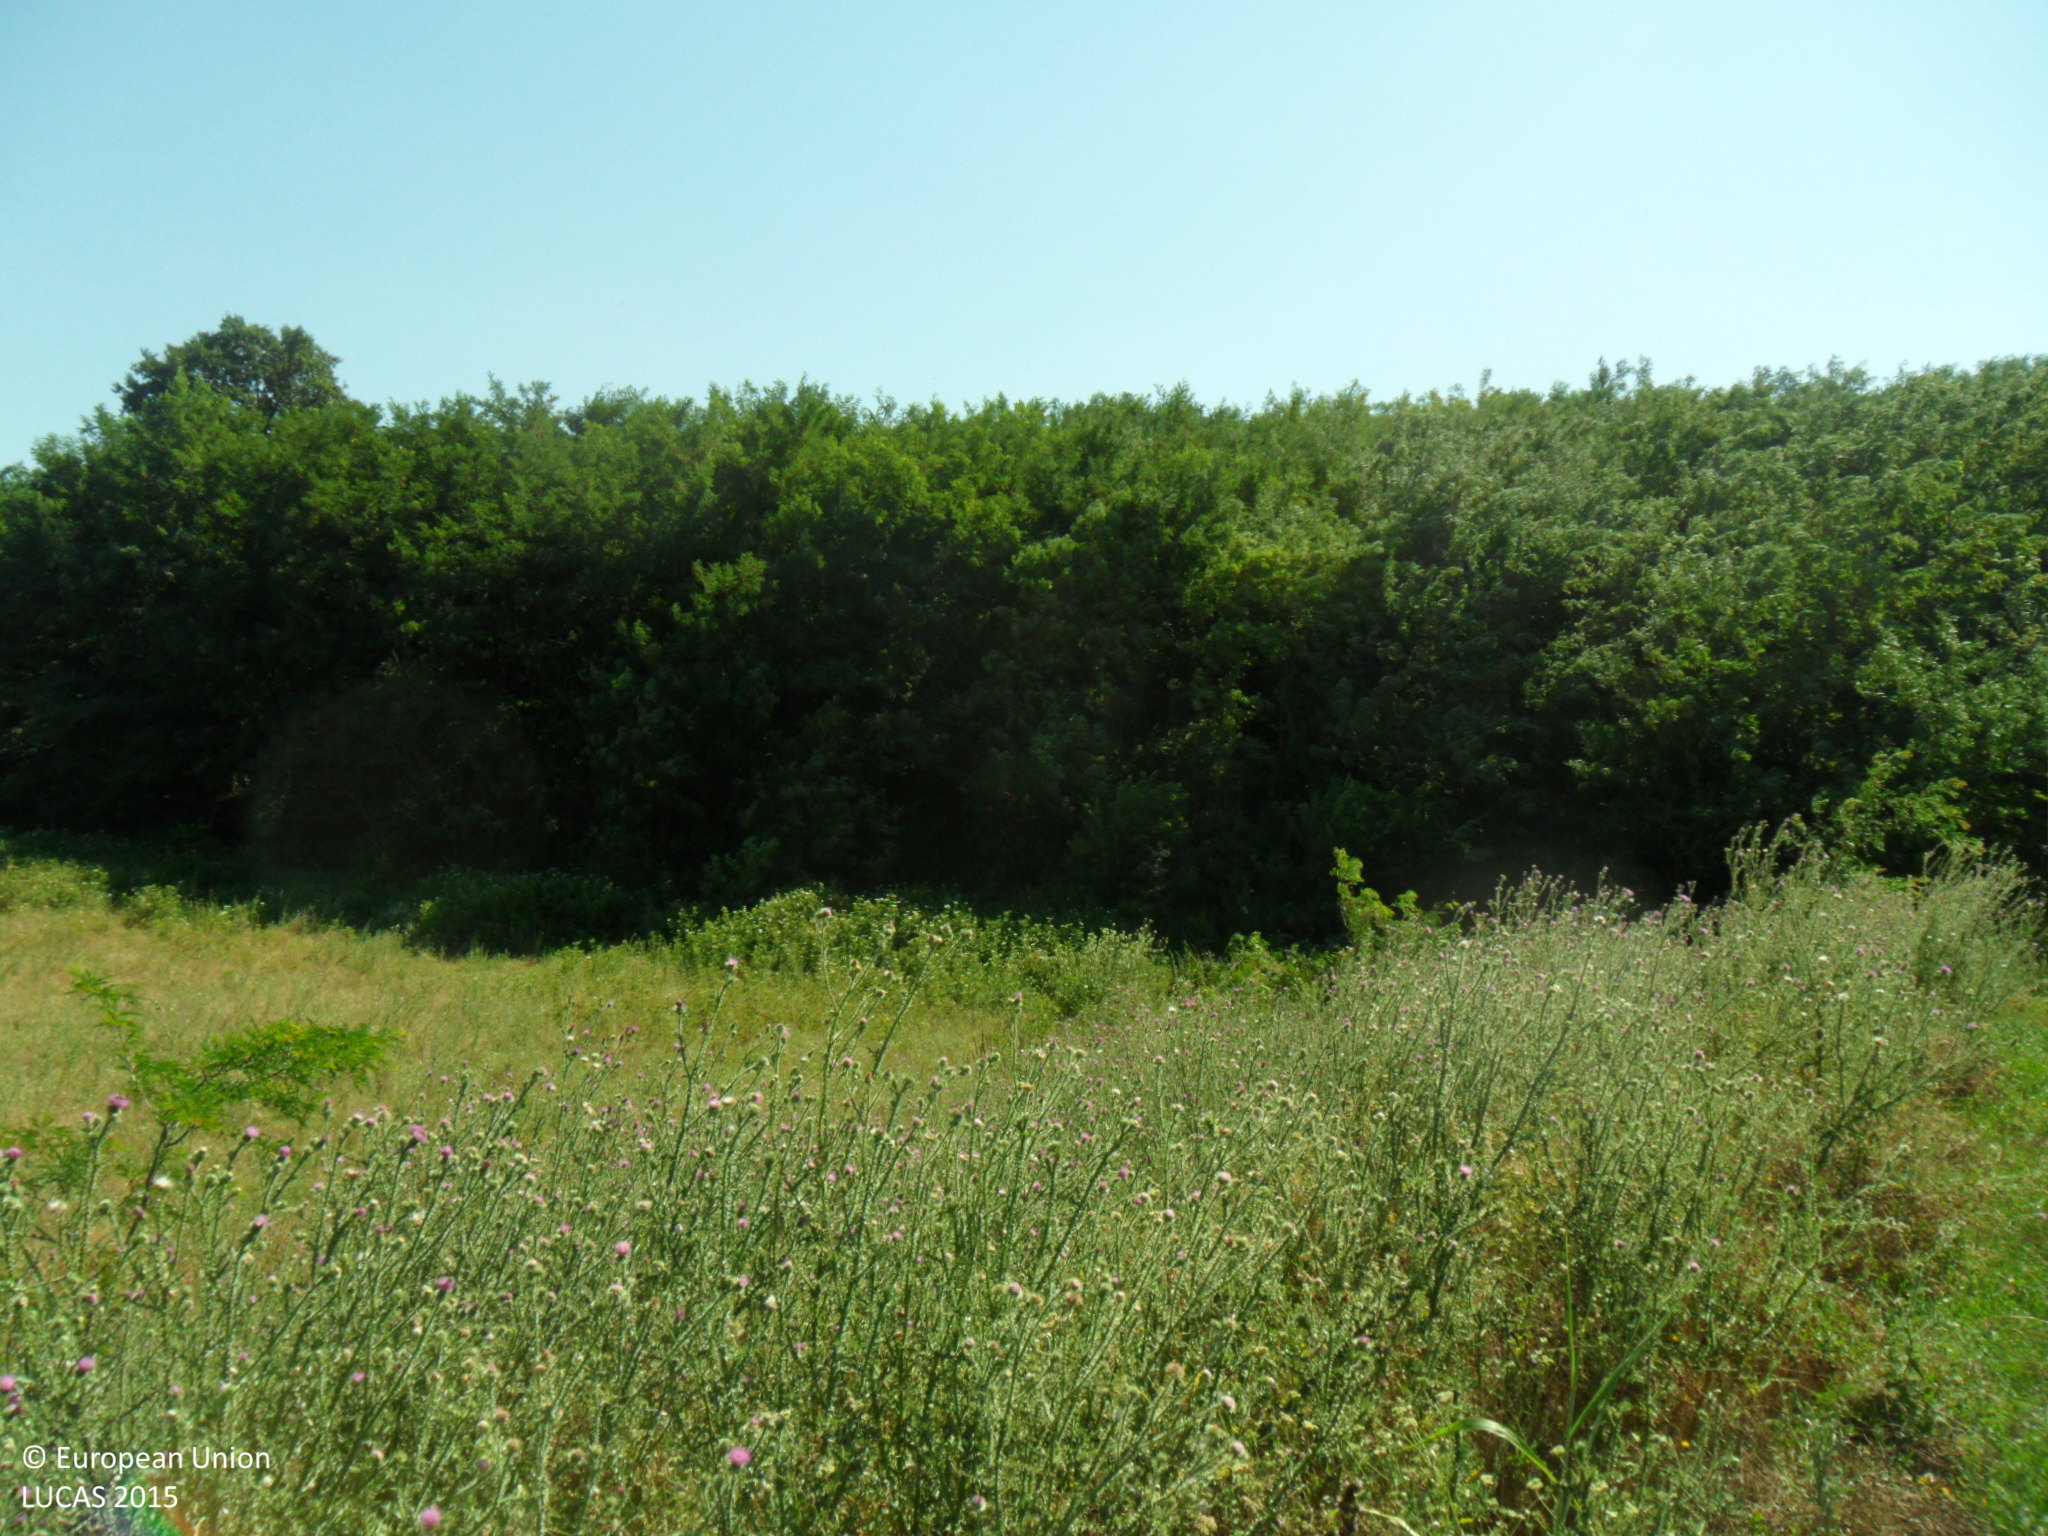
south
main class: Grassland
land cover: Grassland with sparse tree/shrub cover
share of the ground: > 75 %
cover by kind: herbaceous plants 90 %, broadleaved forest trees 5 %, shrubs 5 %
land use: Agriculture (excluding fallow land and kitchen gardens)
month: July
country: BG
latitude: 43.8727
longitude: 26.4469
